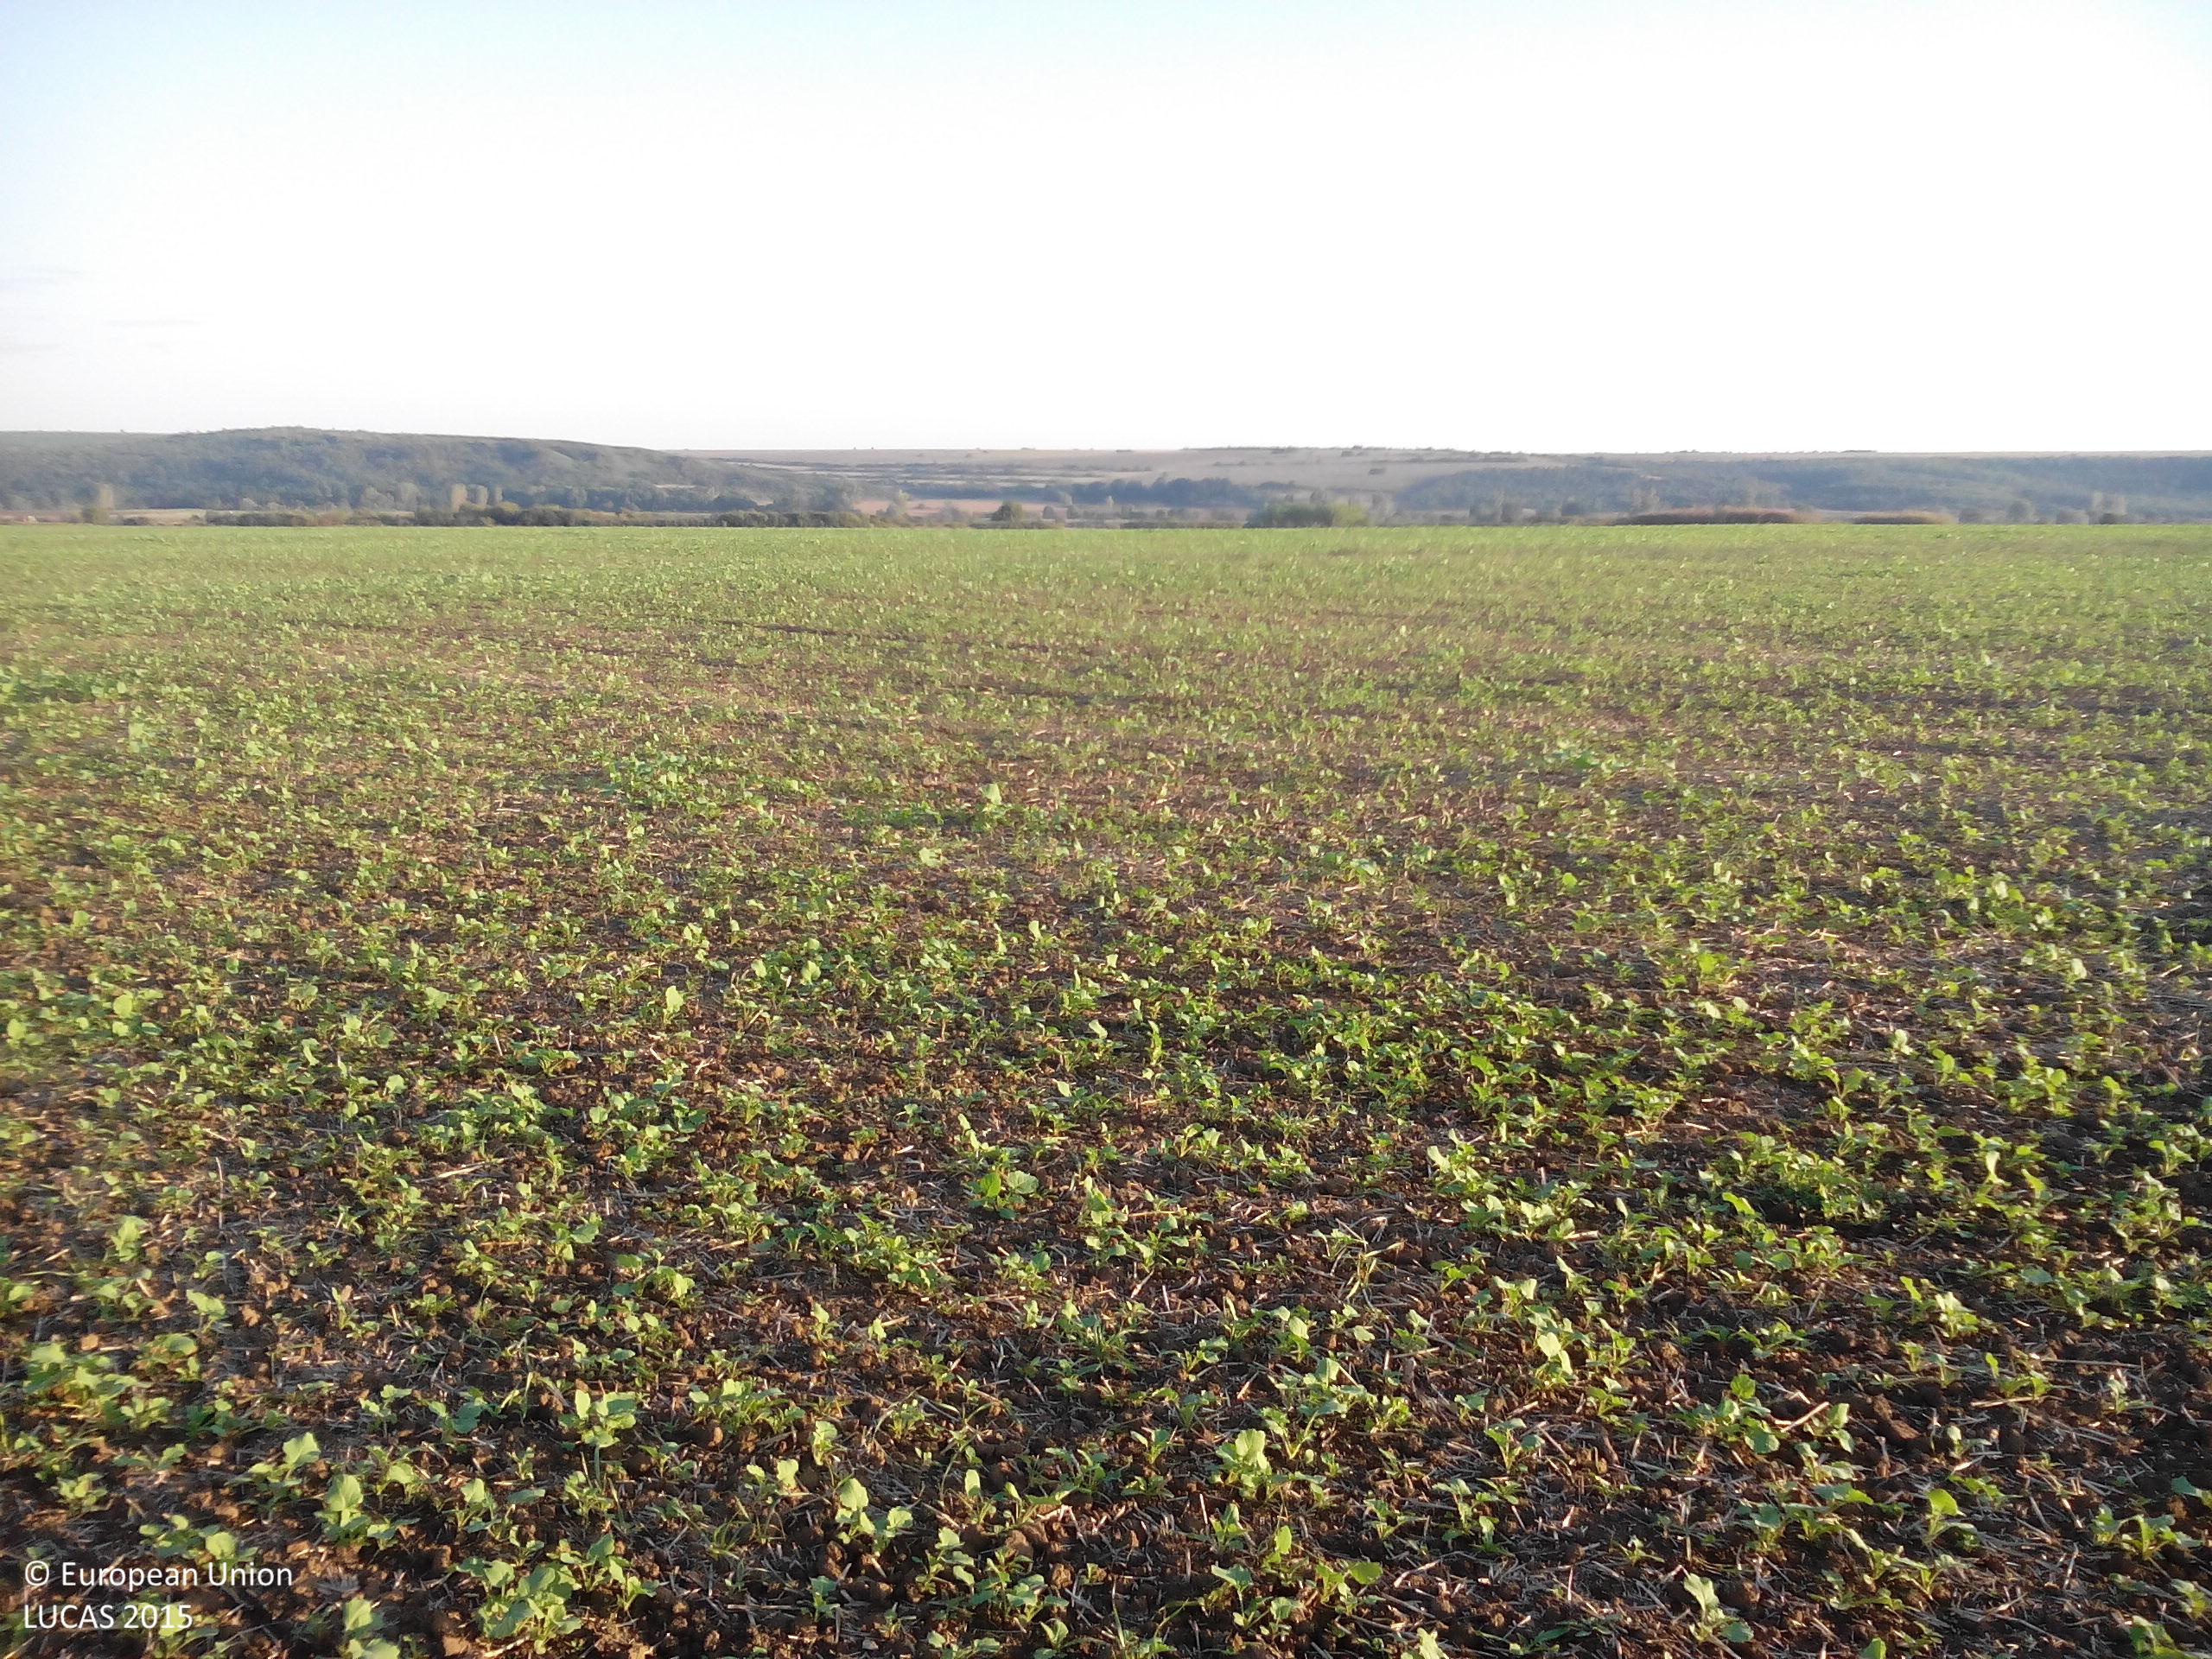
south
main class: Cropland
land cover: Common wheat
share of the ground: < 10 %
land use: Agriculture (excluding fallow land and kitchen gardens)
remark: Harvested field
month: October
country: BG
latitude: 43.5655
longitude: 23.8305
